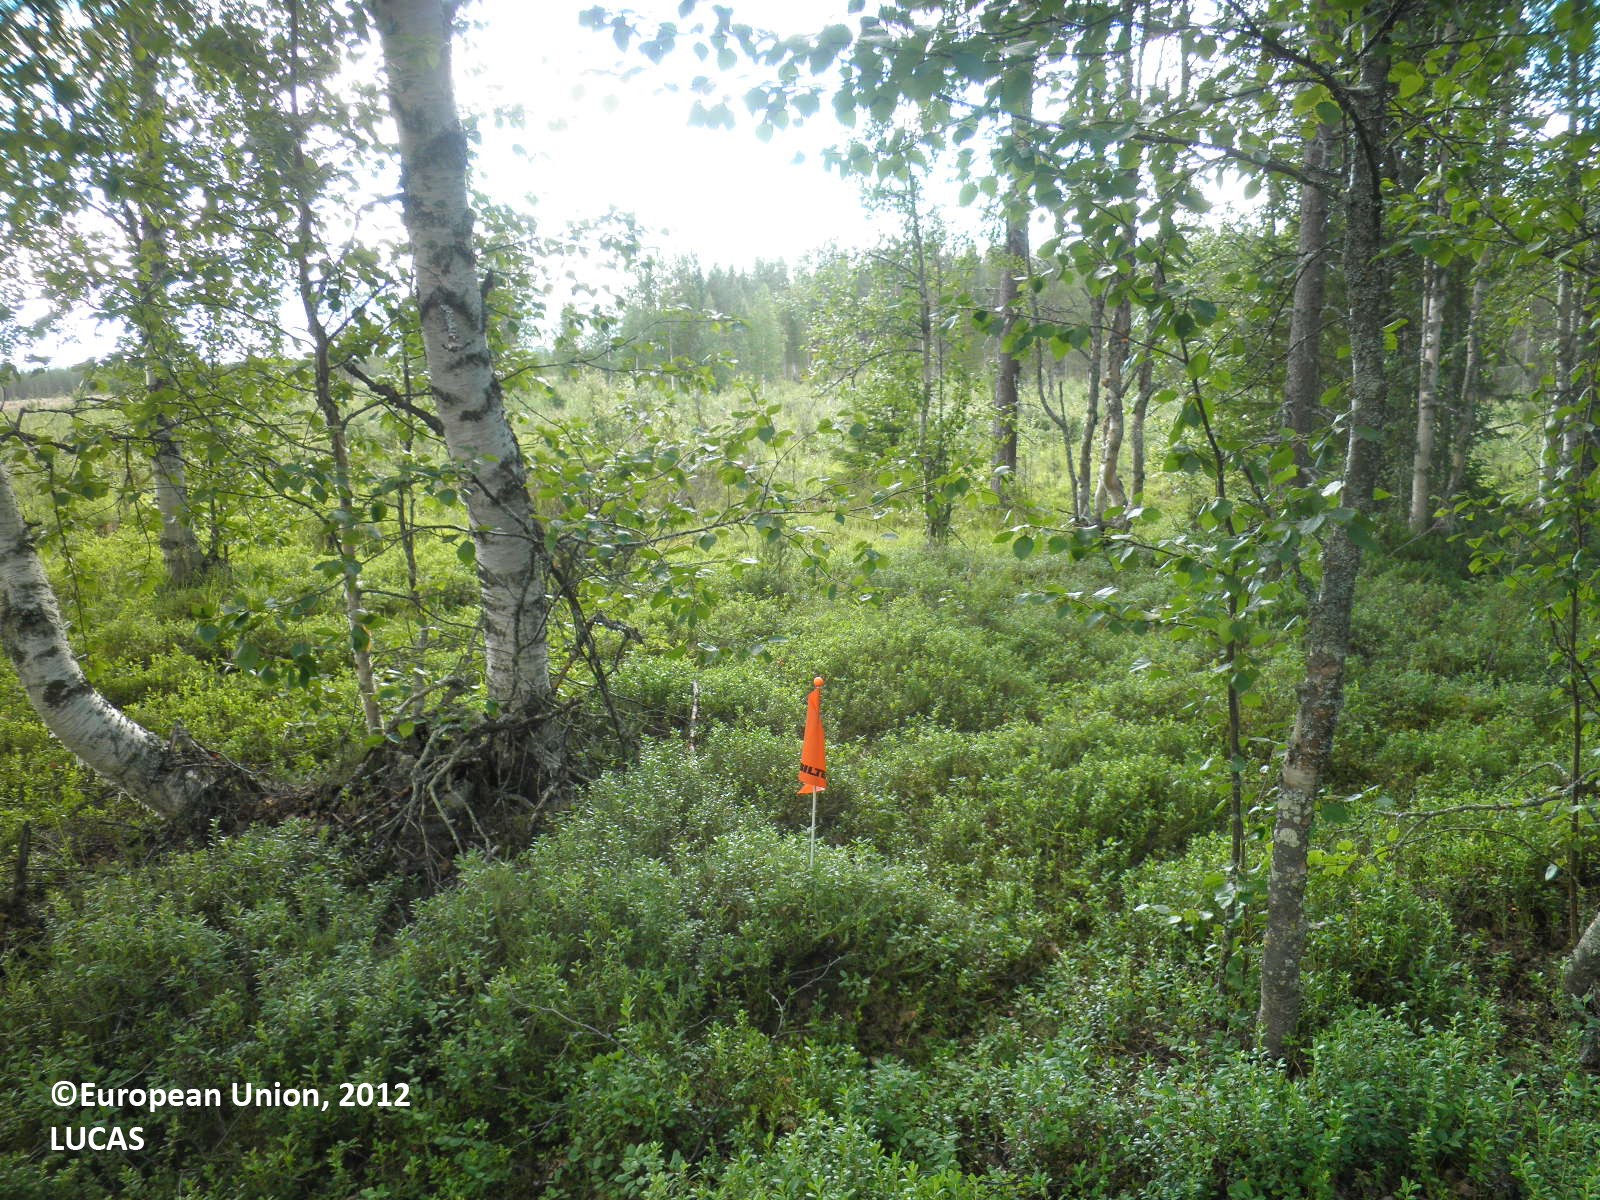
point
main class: Woodland
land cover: Pine dominated mixed woodland
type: boreal forest
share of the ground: 25 - 50 %
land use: Forestry
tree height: > 5 m
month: August
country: FI
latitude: 67.3968
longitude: 27.7566
